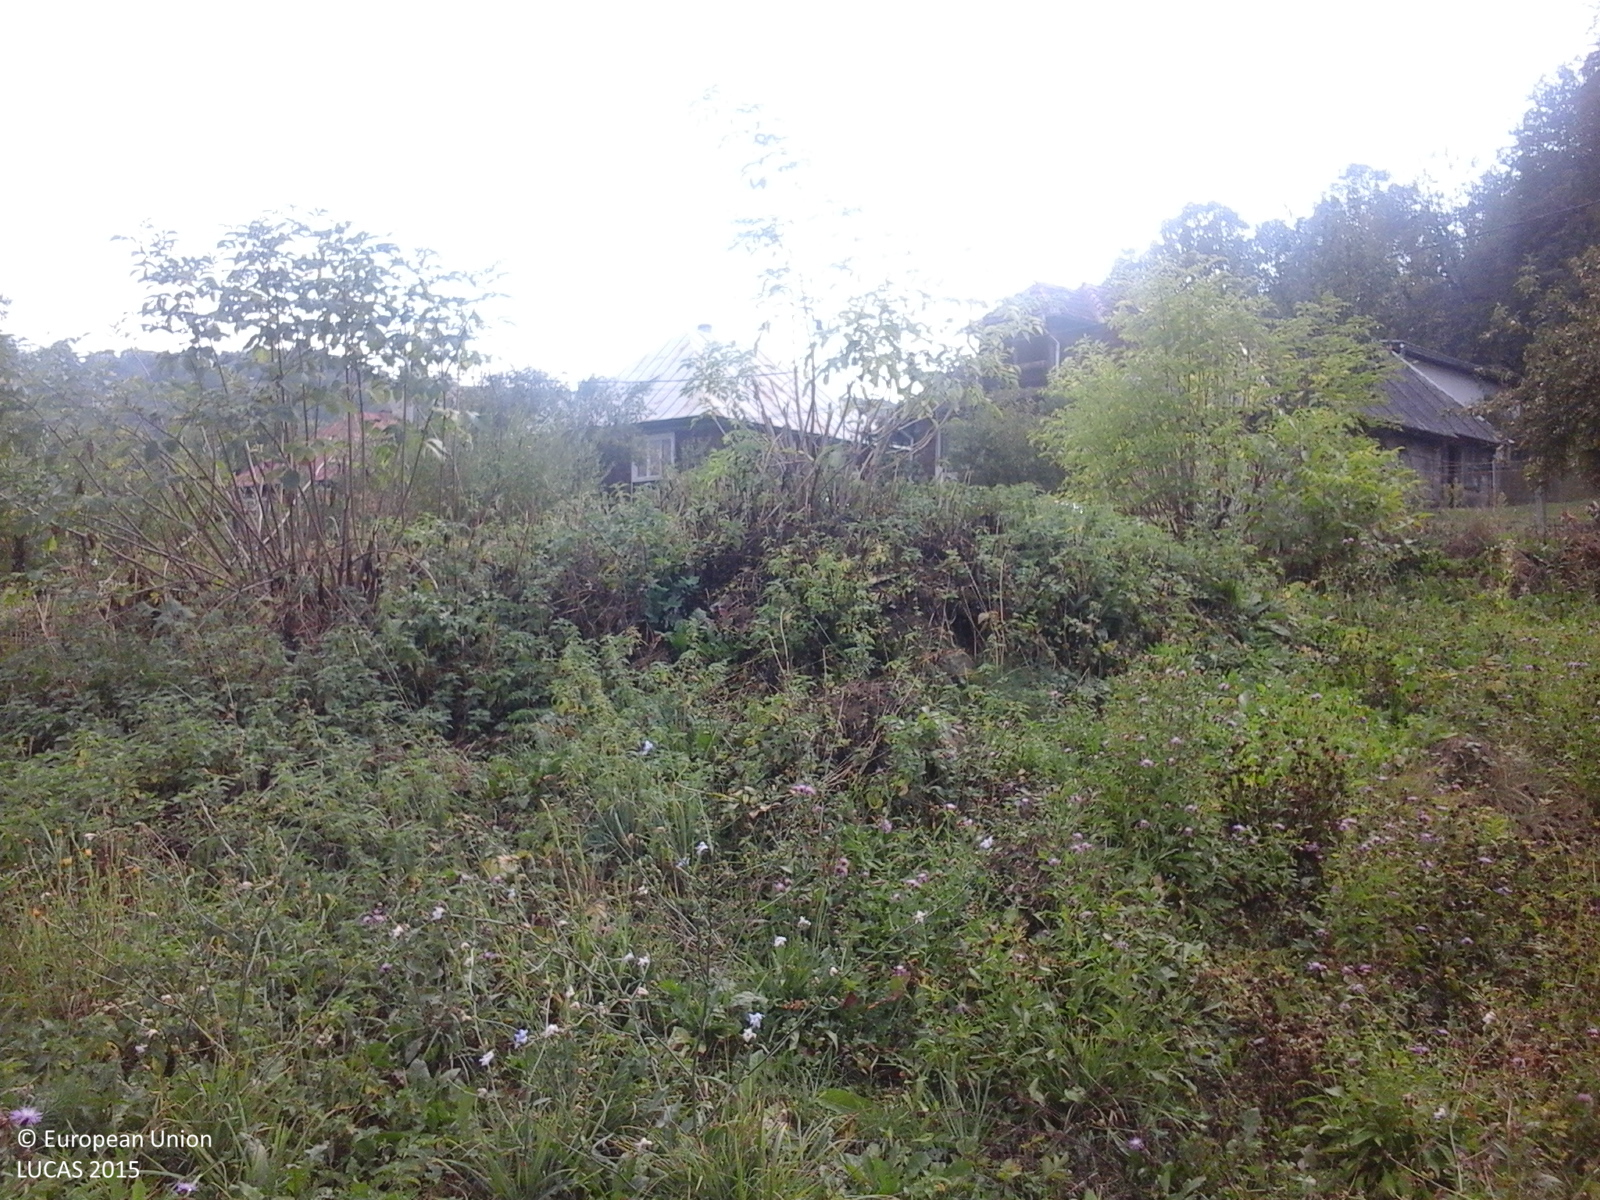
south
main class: Grassland
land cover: Grassland without tree/shrub cover
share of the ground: > 75 %
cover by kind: herbaceous plants 100 %
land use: Agriculture (excluding fallow land and kitchen gardens)
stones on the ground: < 10 %
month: September
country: RO
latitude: 47.8469
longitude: 23.9146
